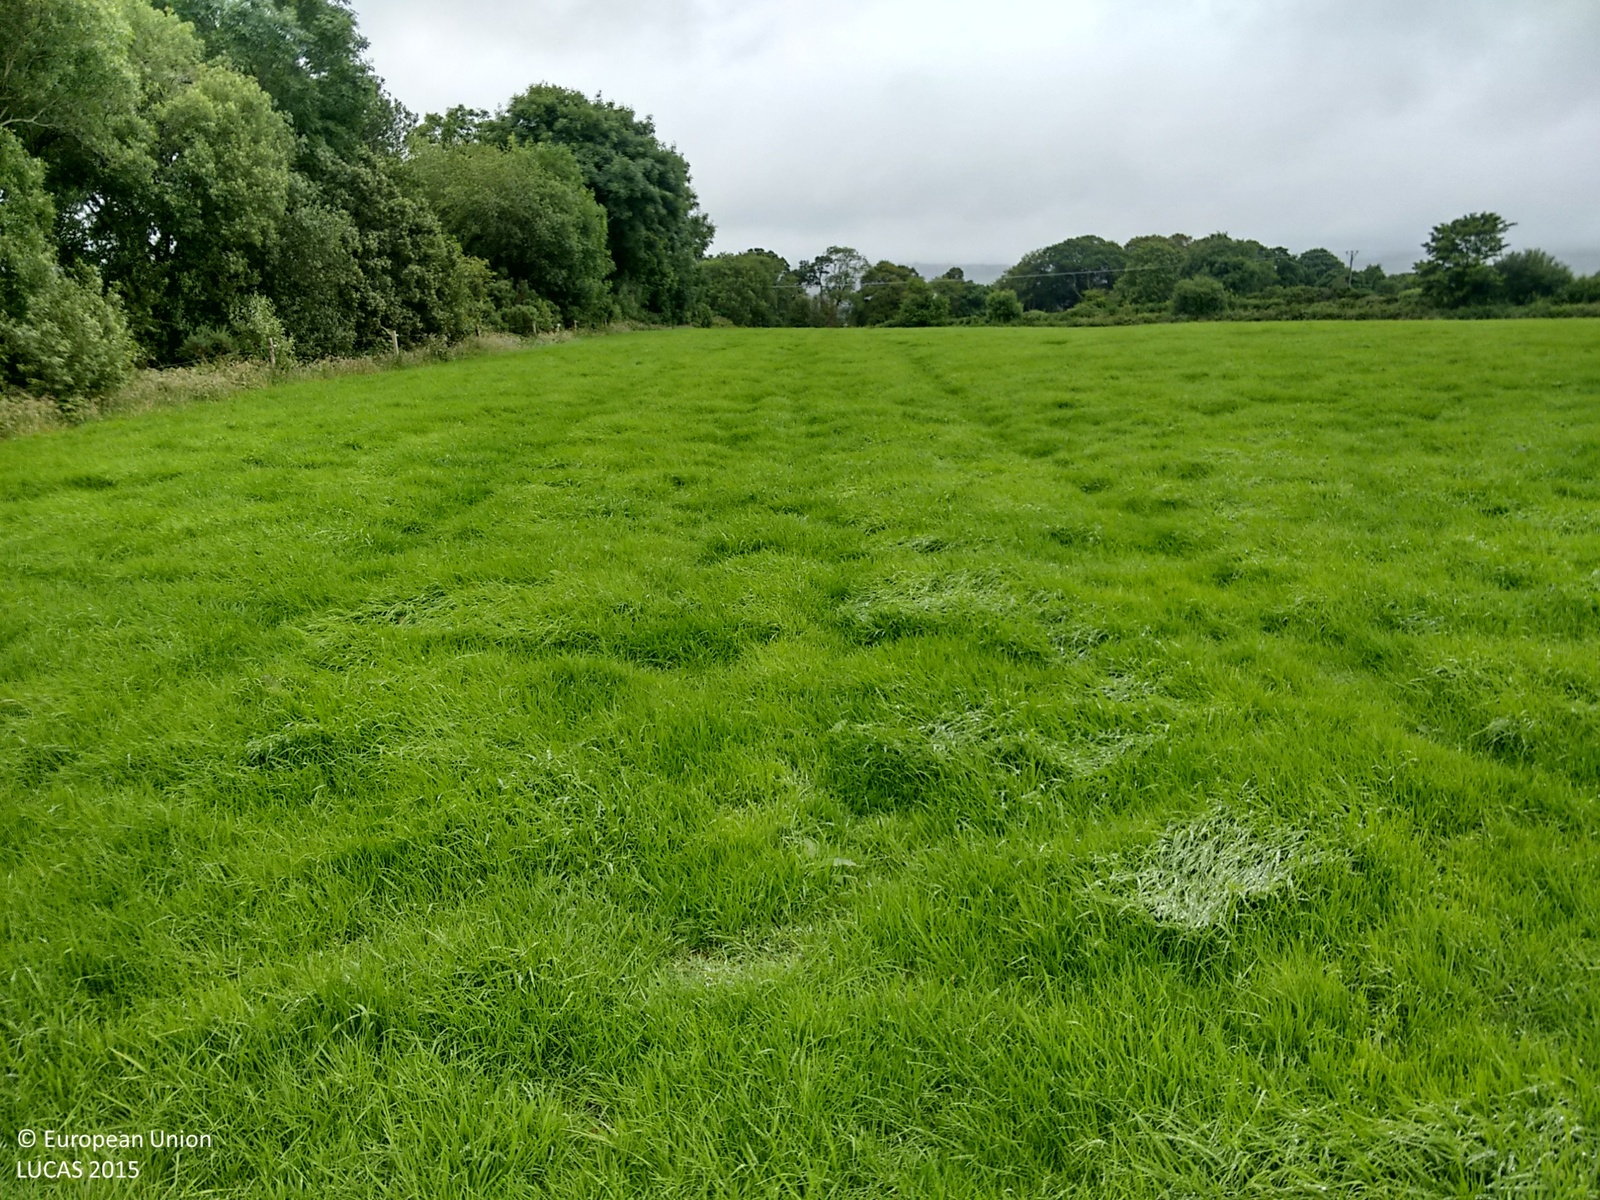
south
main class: Grassland
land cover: Grassland without tree/shrub cover
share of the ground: > 75 %
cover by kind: herbaceous plants 95 %, shrubs 5 %
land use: Agriculture (excluding fallow land and kitchen gardens)
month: July
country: IE
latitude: 51.7282
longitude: -9.1111
